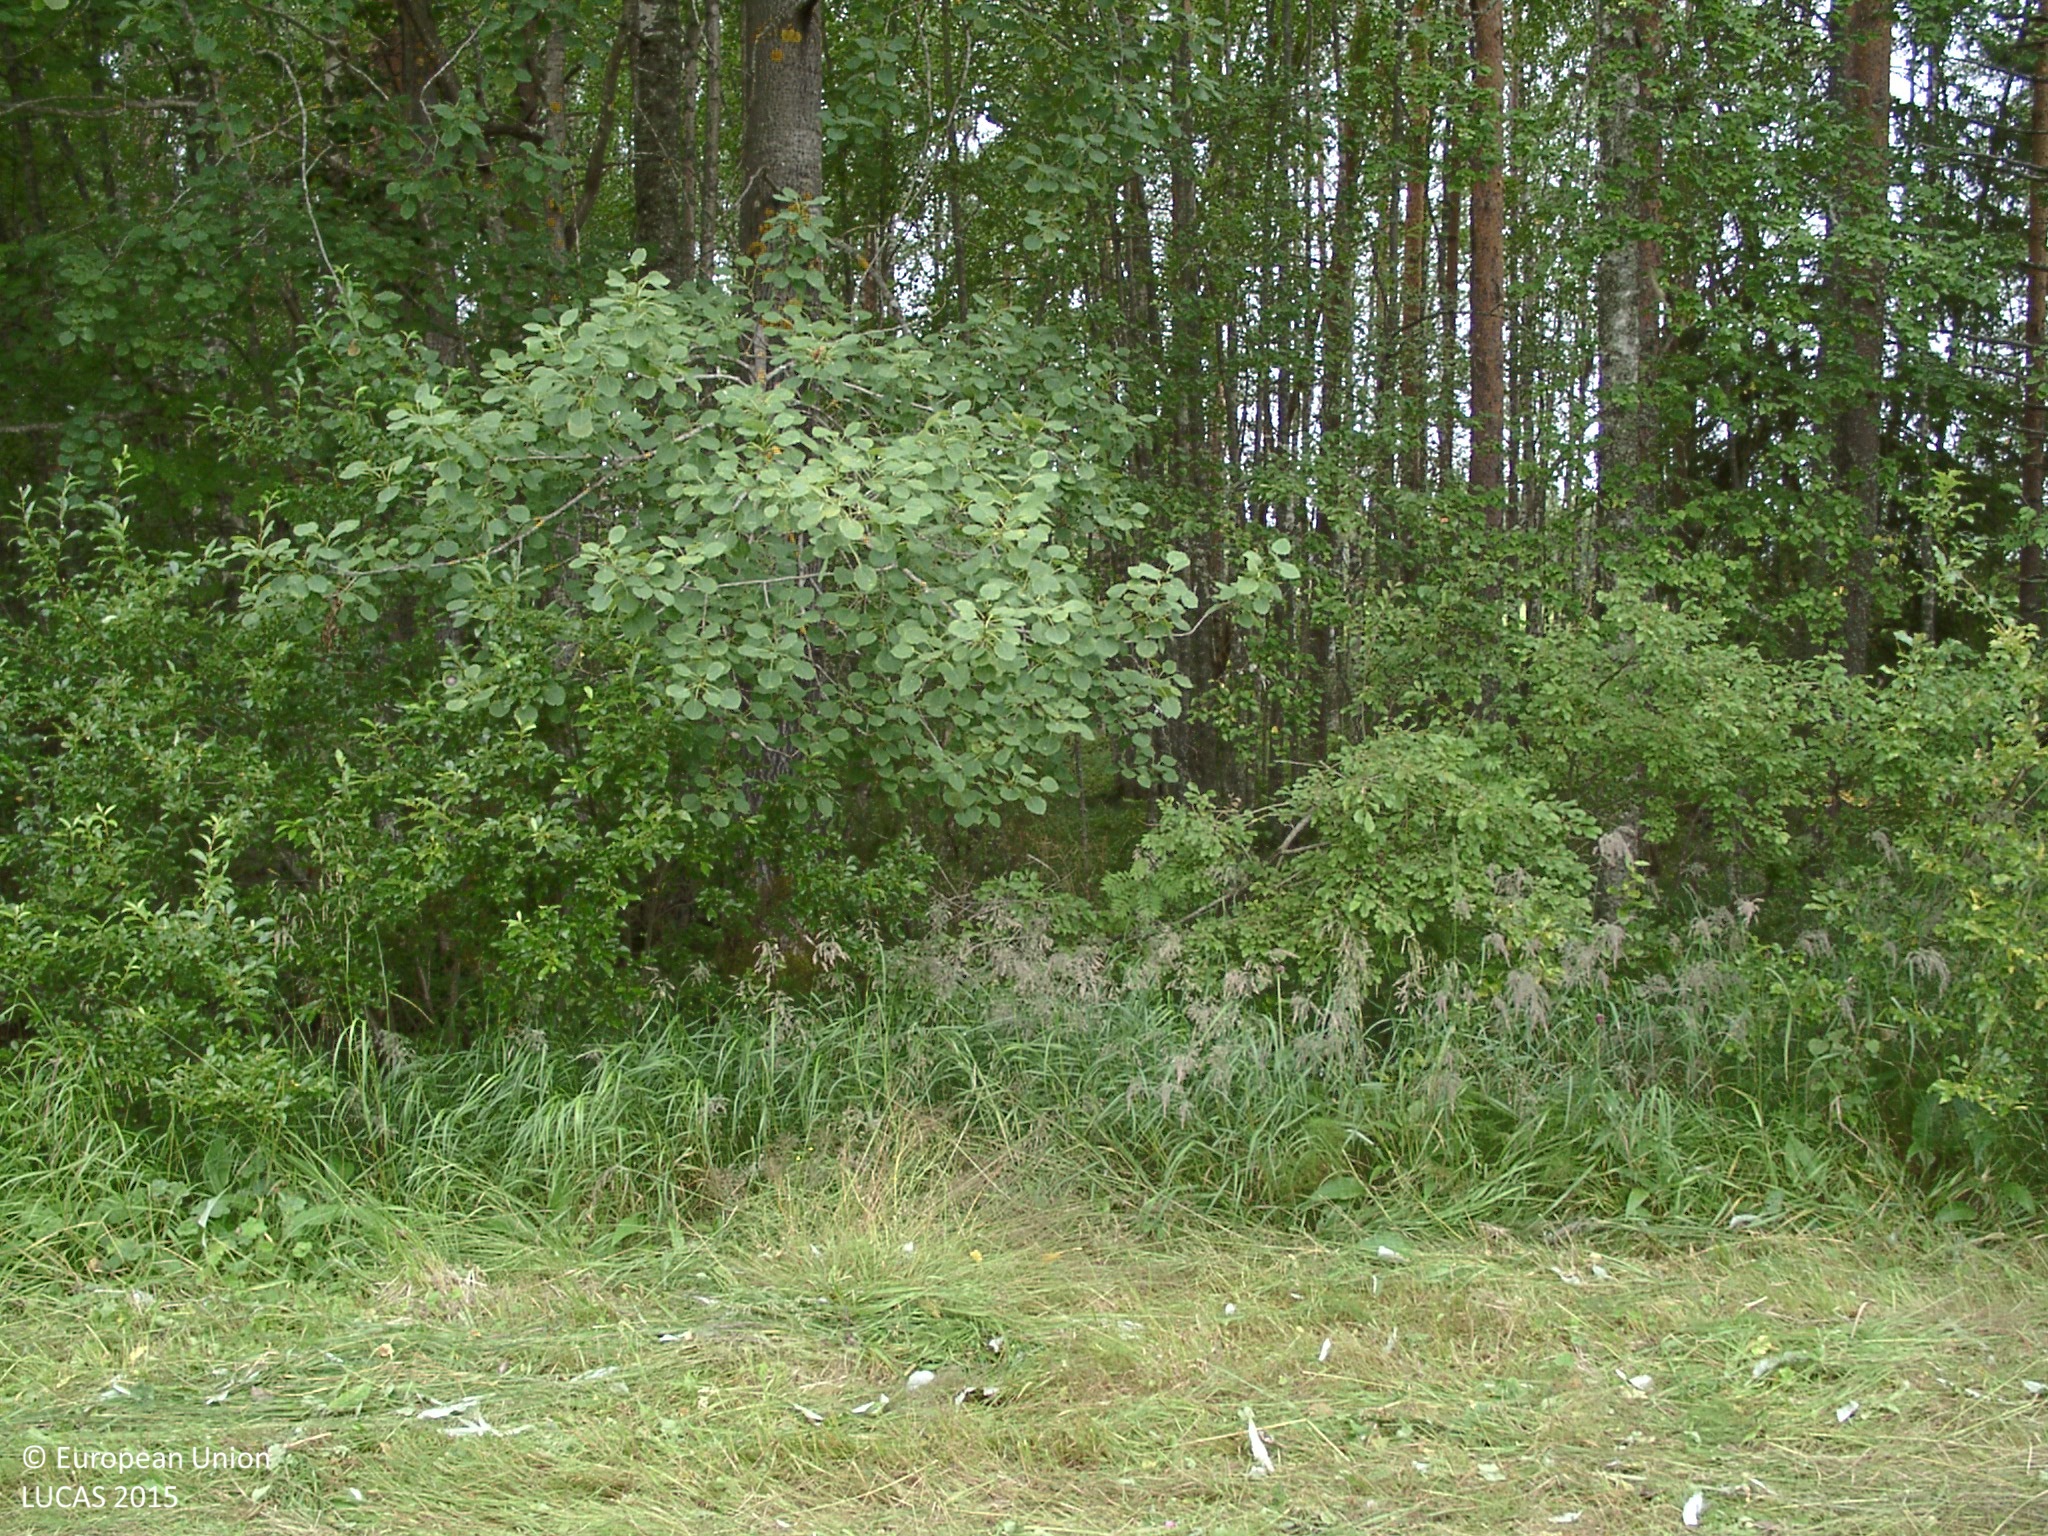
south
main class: Grassland
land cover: Spontaneously vegetated surfaces
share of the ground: > 75 %
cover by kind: herbaceous plants 100 %
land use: Fallow land
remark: Harvested field
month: August
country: FI
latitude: 62.6898
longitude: 24.5660
